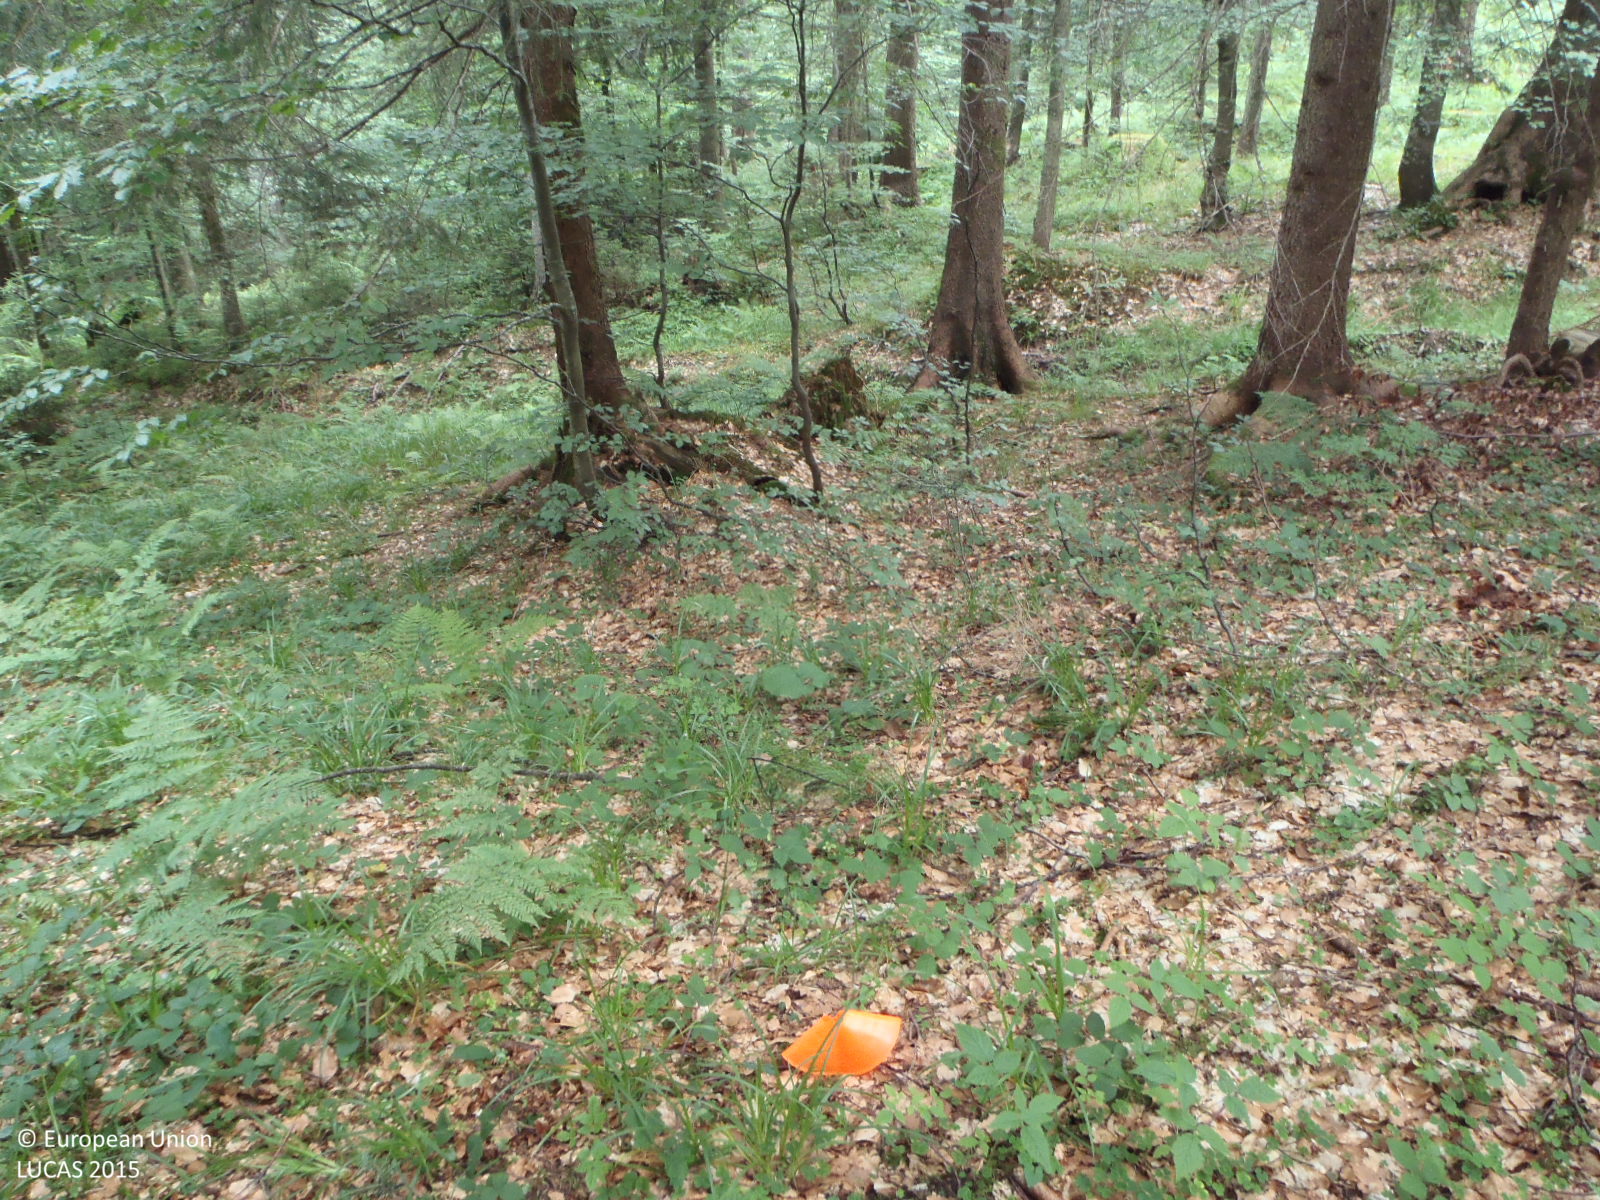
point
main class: Woodland
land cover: Spruce dominated mixed woodland
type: alpine coniferous forest
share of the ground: > 75 %
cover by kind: coniferous forest trees 55 %, broadleaved forest trees 30 %, herbaceous plants 10 %, unconsolidated bare surface 5 %
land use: Forestry
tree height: > 5 m
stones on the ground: < 10 %
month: July
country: AT
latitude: 47.5036
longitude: 9.9867
